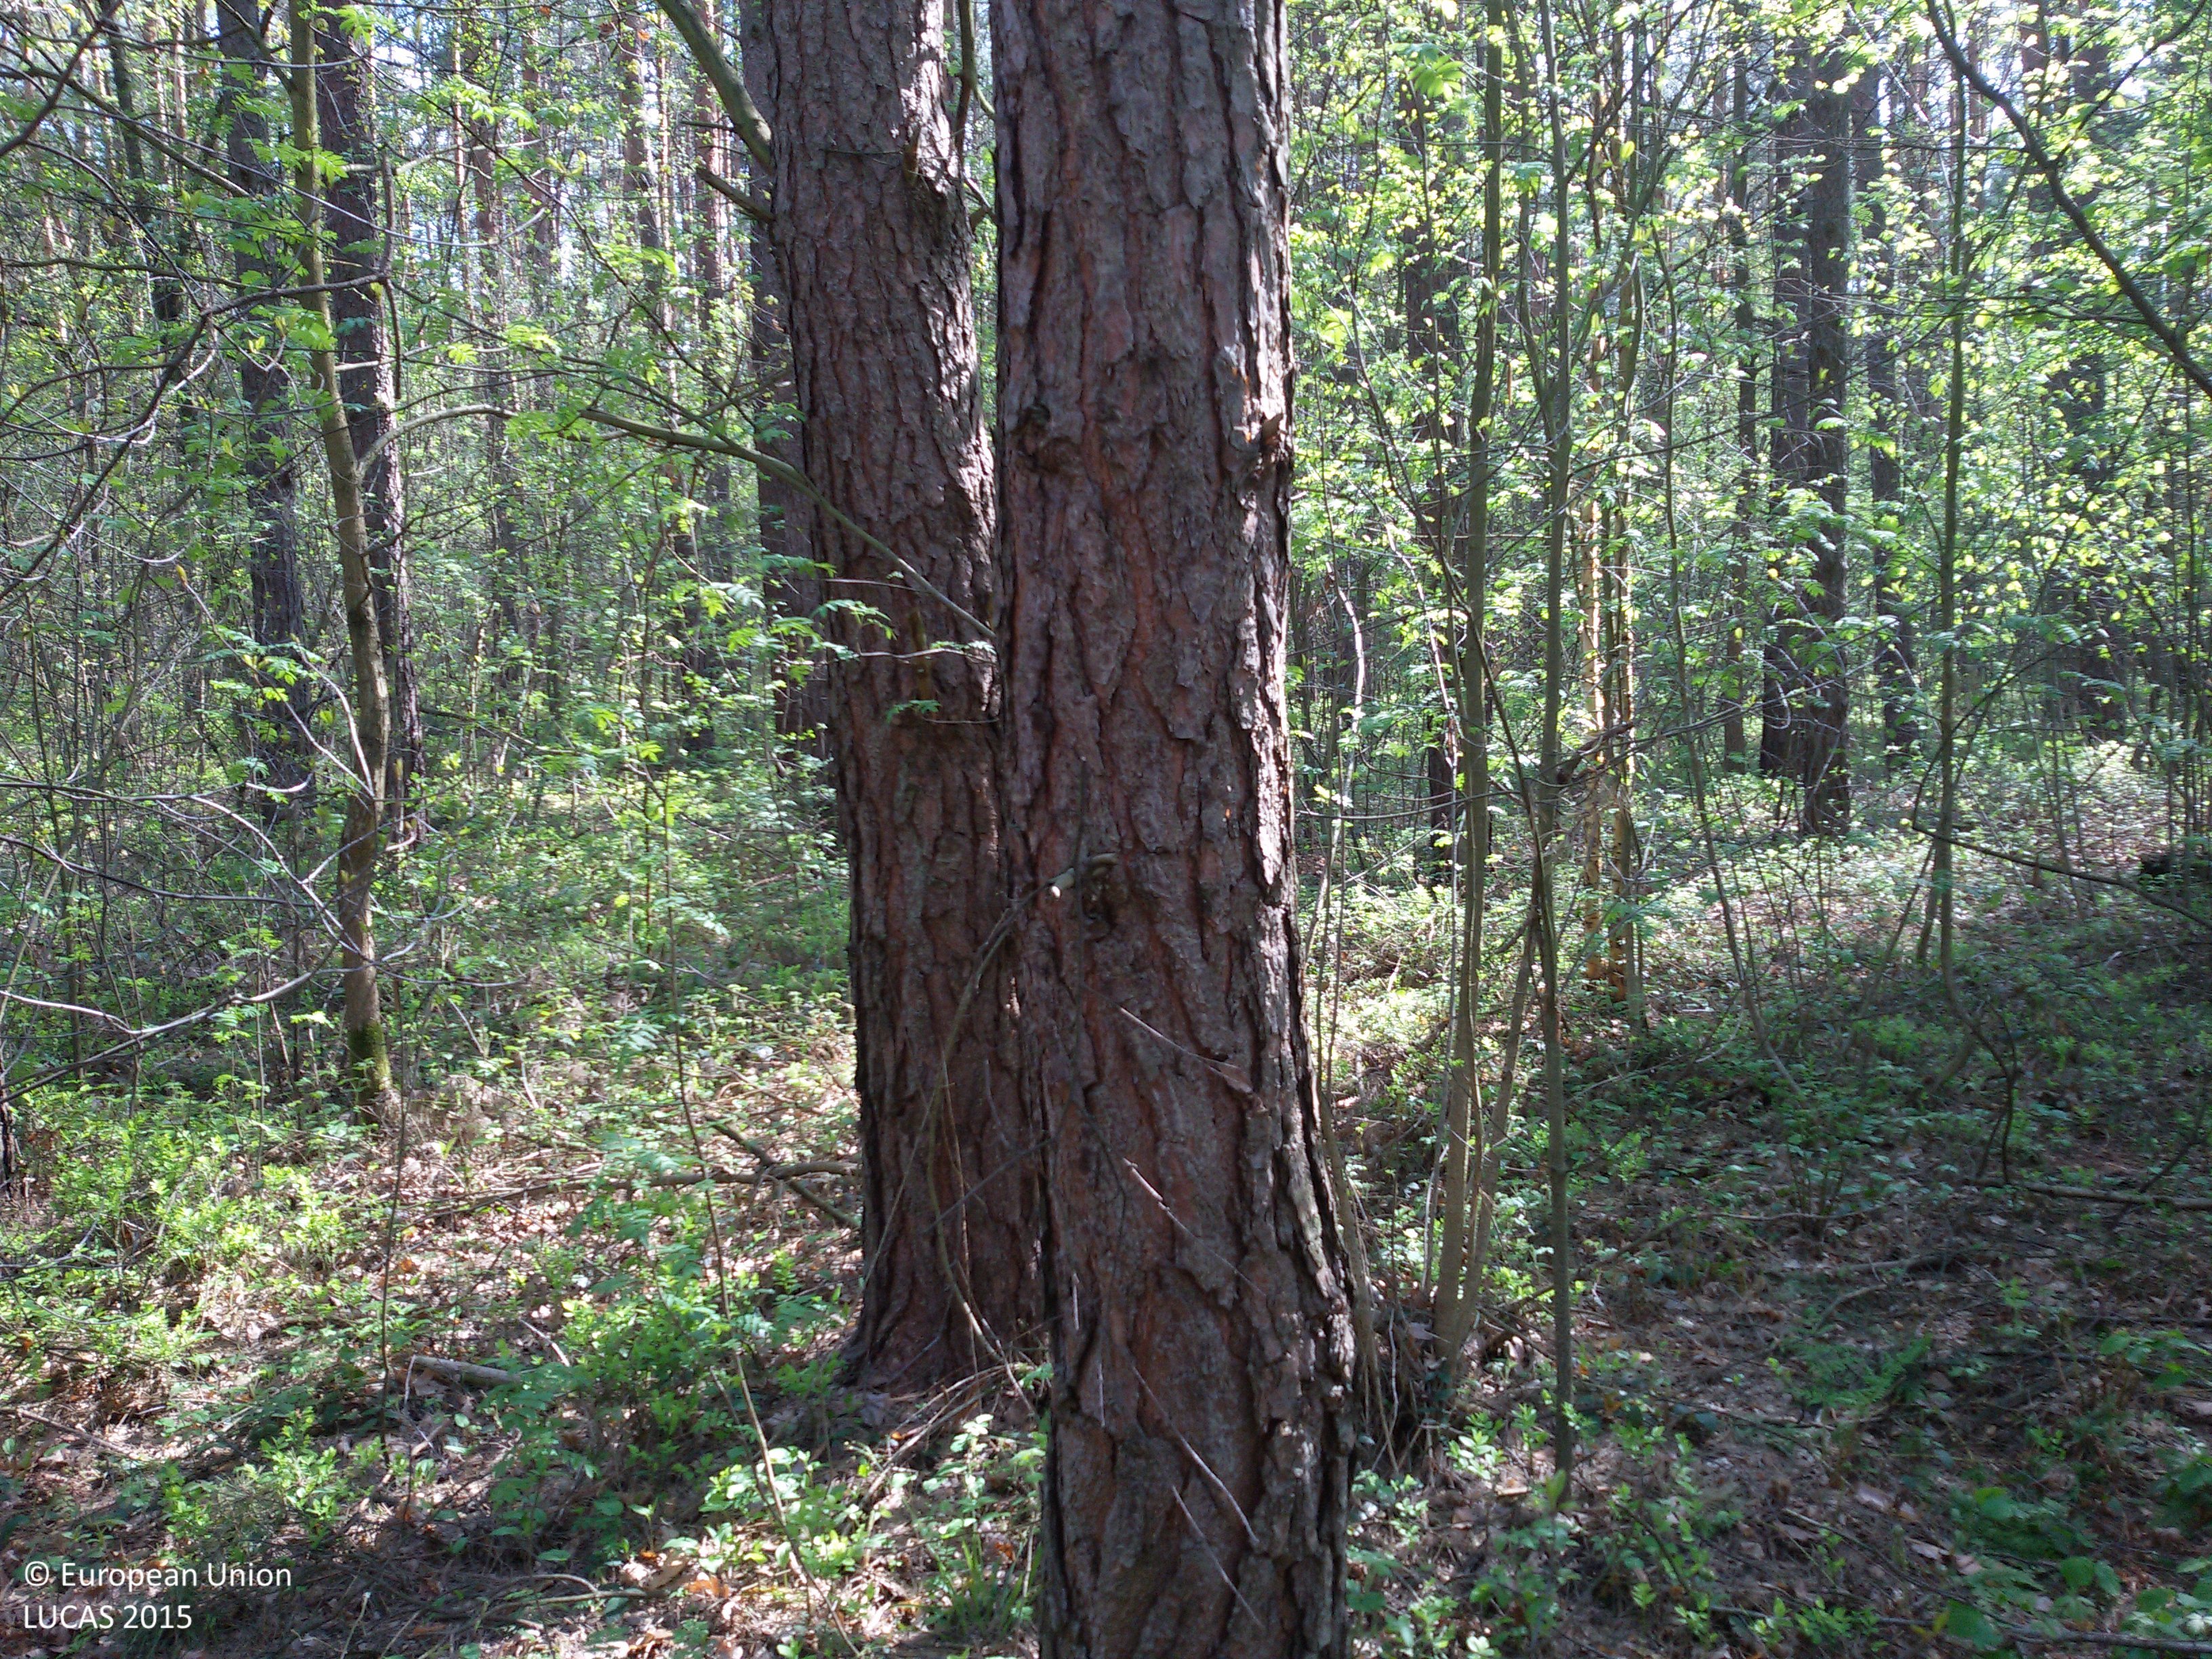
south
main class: Woodland
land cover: Pine dominated mixed woodland
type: hemiboreal forest and nemoral coniferous forest and mixed broadleaved-coniferous forest
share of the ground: > 75 %
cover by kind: coniferous forest trees 65 %, broadleaved forest trees 25 %, shrubs 5 %, herbaceous plants 5 %
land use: Forestry
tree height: > 5 m
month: May
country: PL
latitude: 51.8761
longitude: 21.0703
